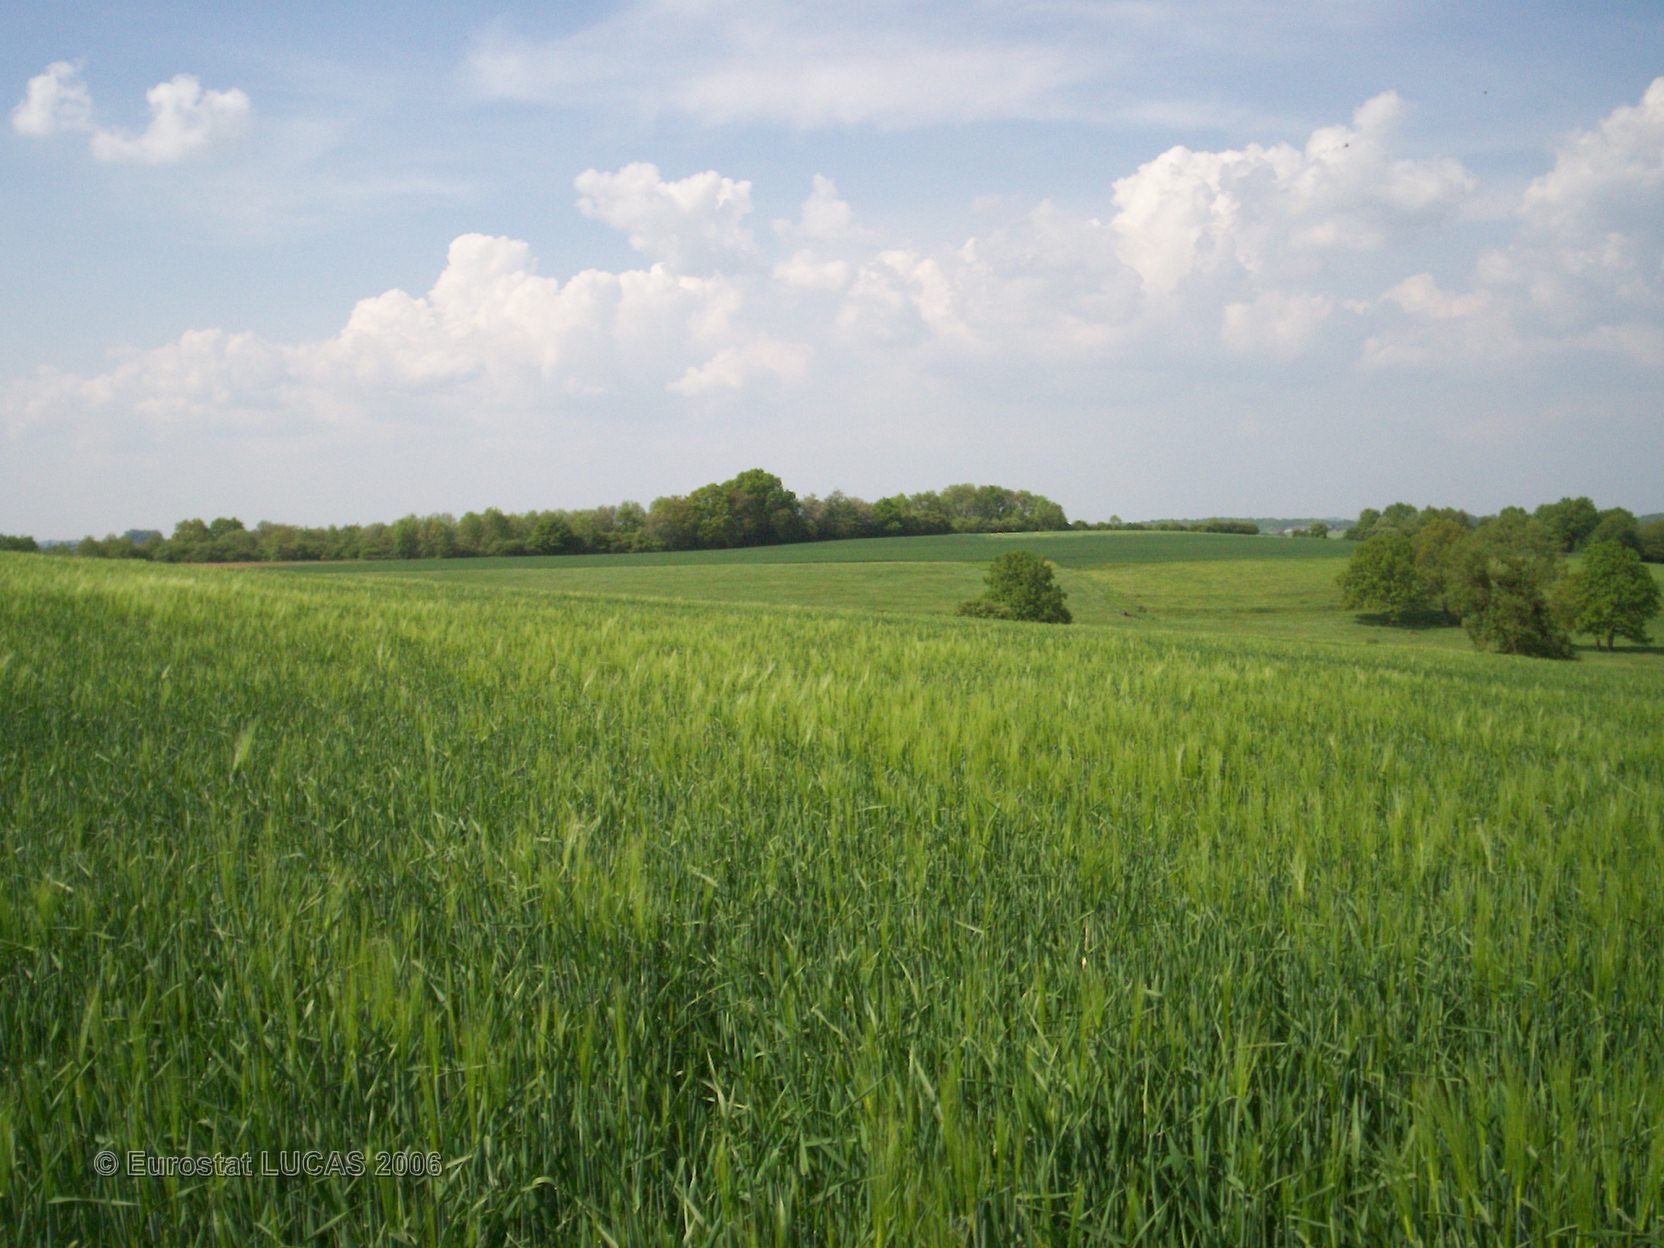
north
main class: Cropland
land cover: Barley
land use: Agriculture (excluding fallow land and kitchen gardens)
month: May
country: FR
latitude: 49.6632
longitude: 4.3015
